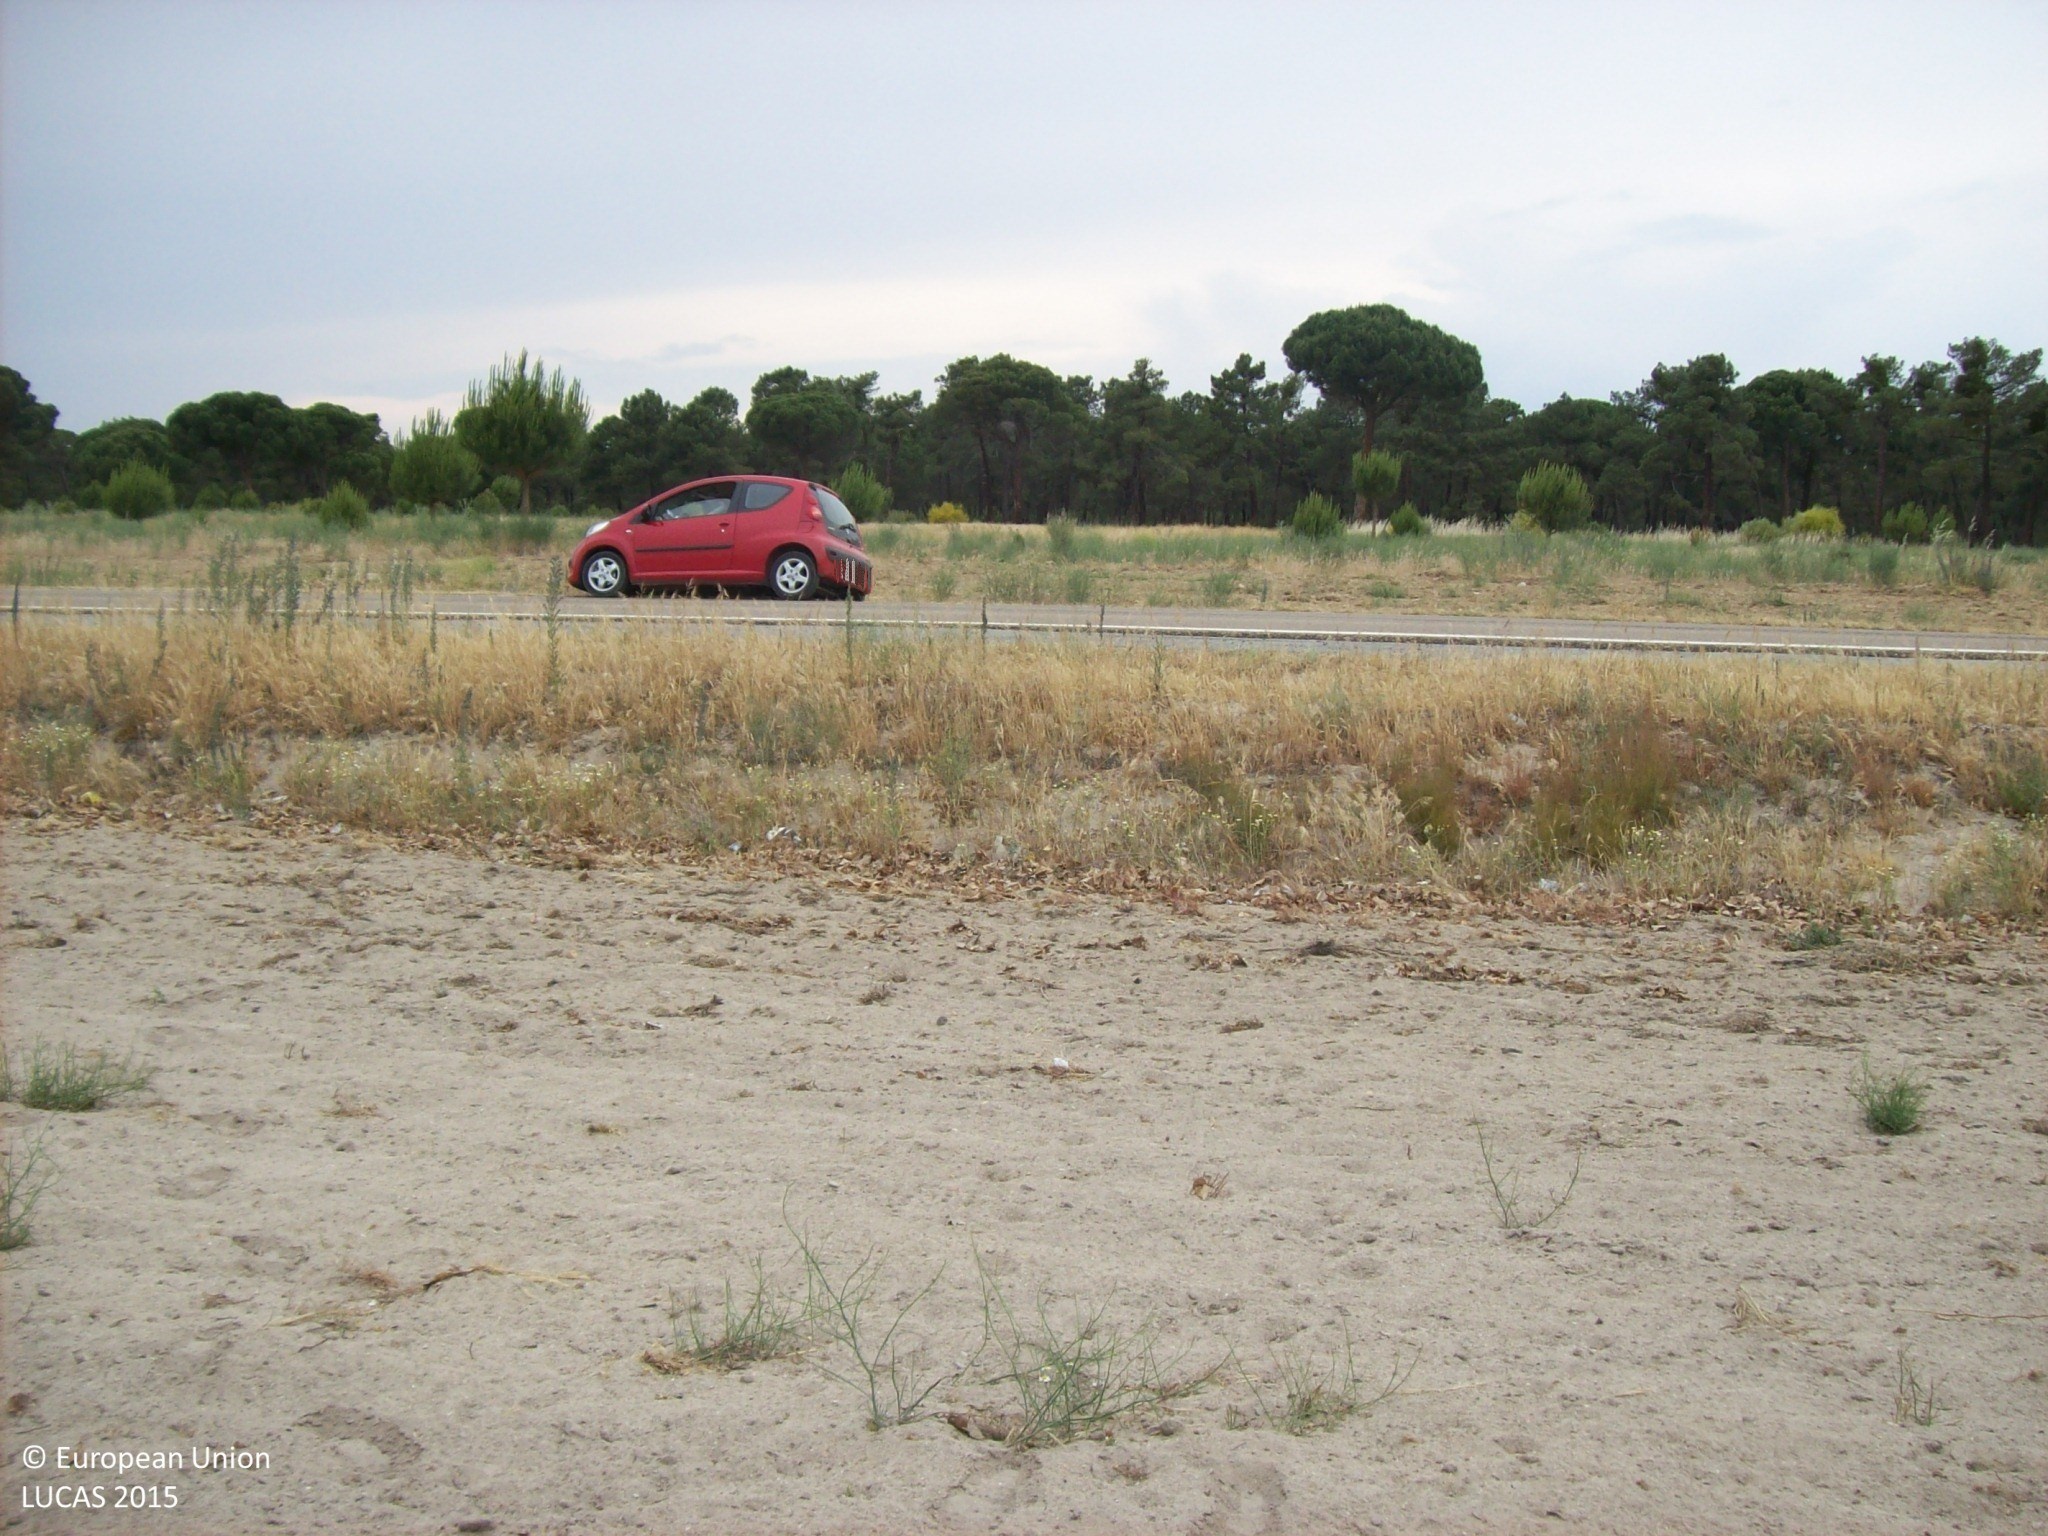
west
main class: Woodland
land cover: Pine dominated coniferous woodland
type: coniferous forest of the mediterranean region
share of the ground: 10 - 25 %
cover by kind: herbaceous plants 35 %, coniferous forest trees 25 %, unconsolidated bare surface 25 %
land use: Forestry
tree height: < 5 m
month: June
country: ES
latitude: 41.1942
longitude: -4.5473
